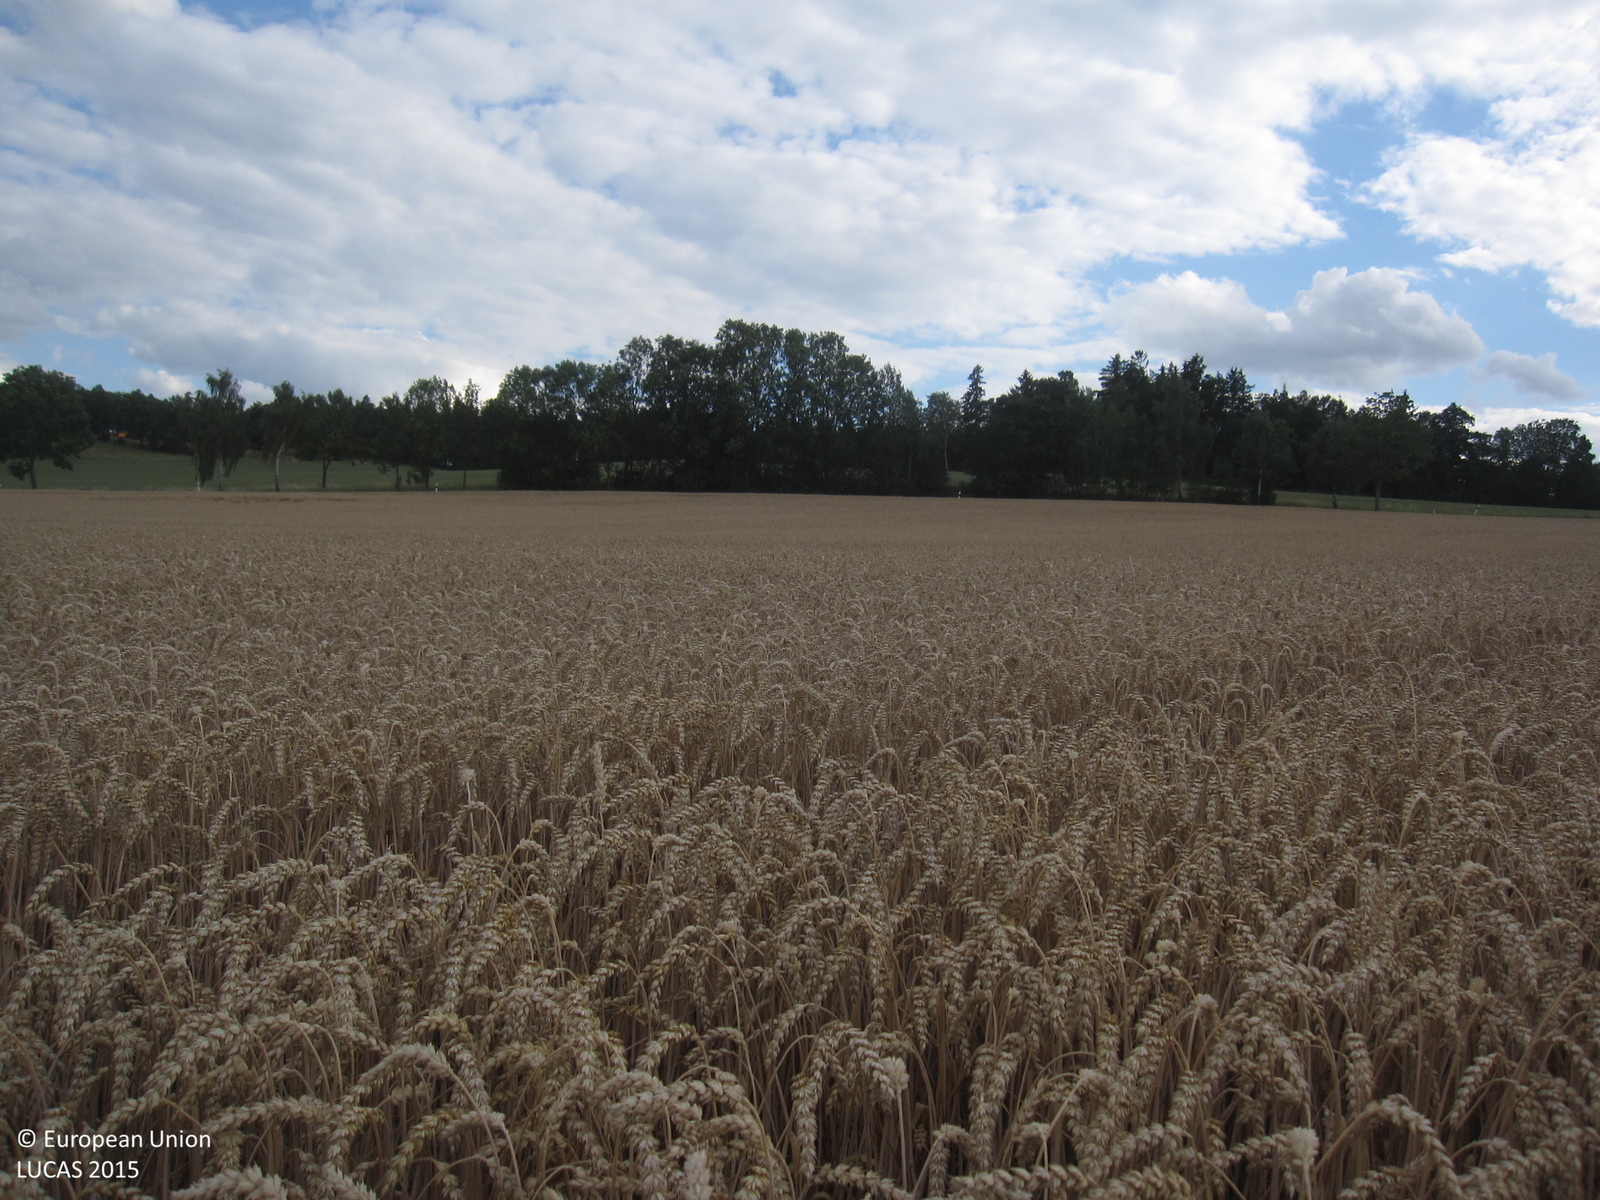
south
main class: Cropland
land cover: Common wheat
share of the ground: > 75 %
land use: Agriculture (excluding fallow land and kitchen gardens)
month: July
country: DE
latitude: 50.4727
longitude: 11.9863
